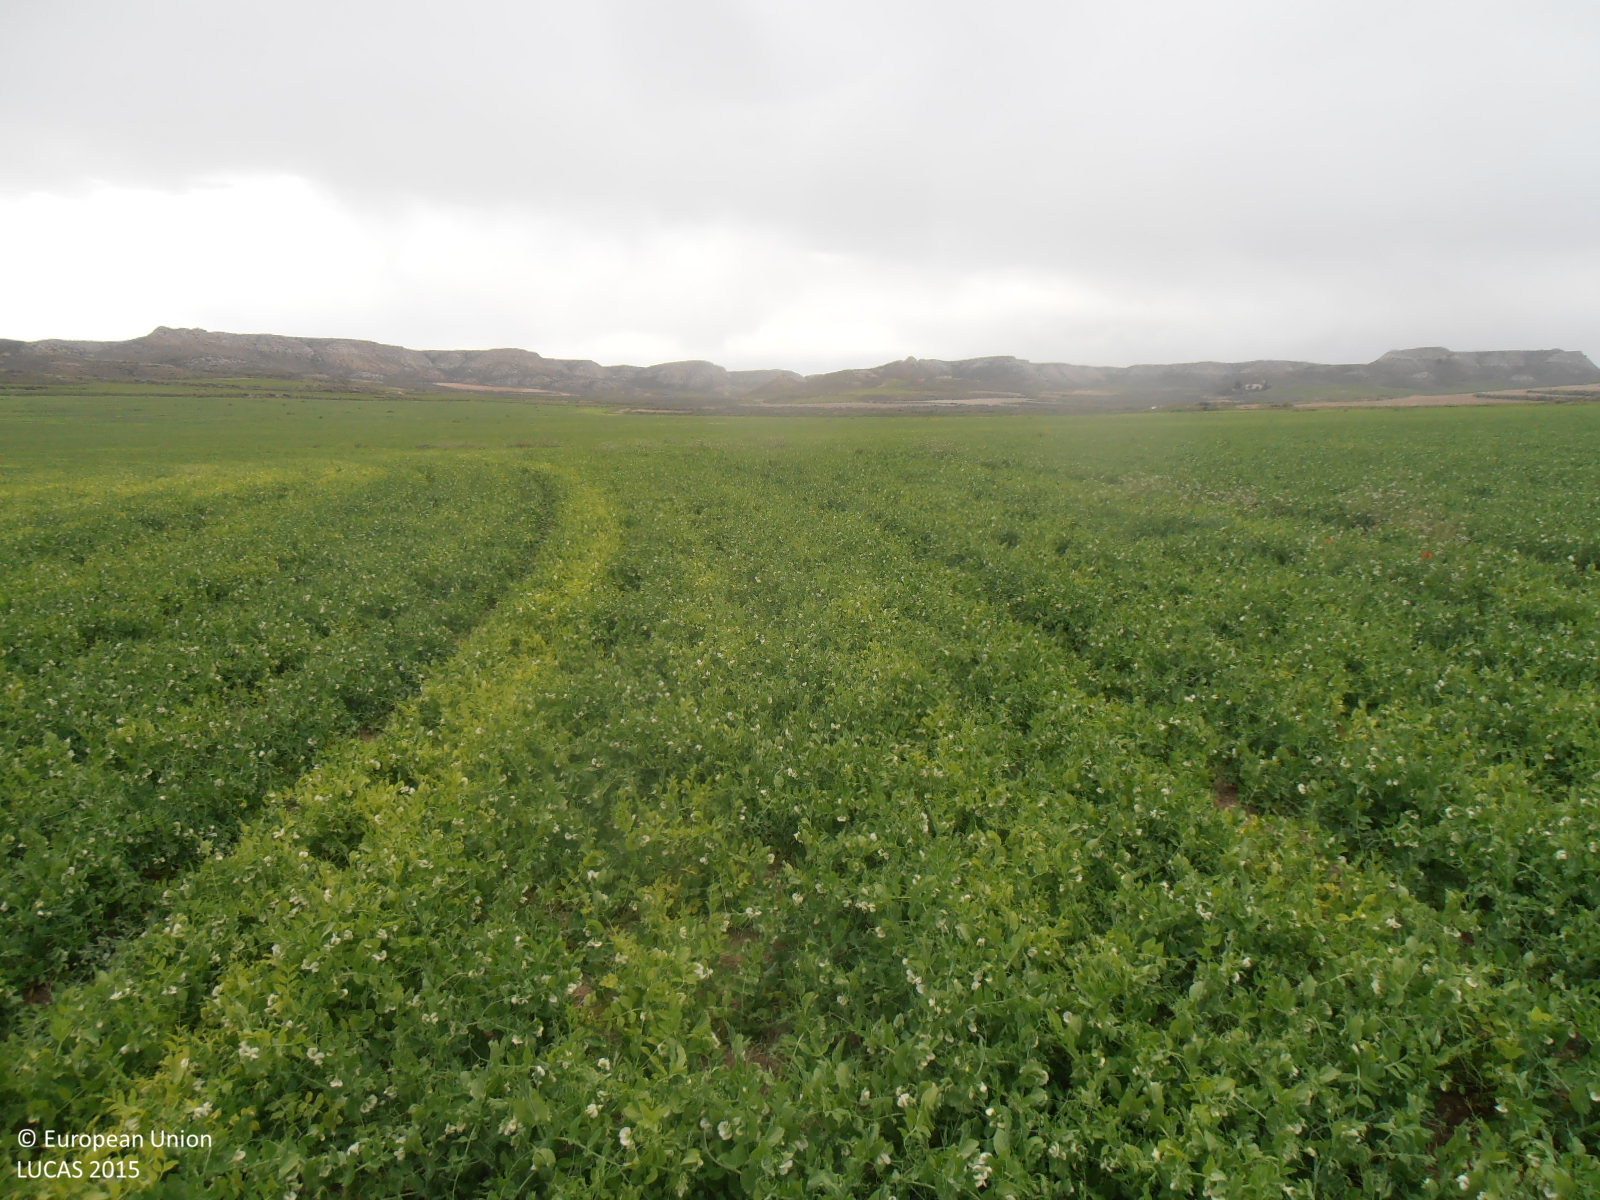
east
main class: Cropland
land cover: Dry pulses
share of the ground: > 75 %
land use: Agriculture (excluding fallow land and kitchen gardens)
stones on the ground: < 10 %
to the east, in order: Dry pulses
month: April
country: ES
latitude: 41.4445
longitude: -0.3938
